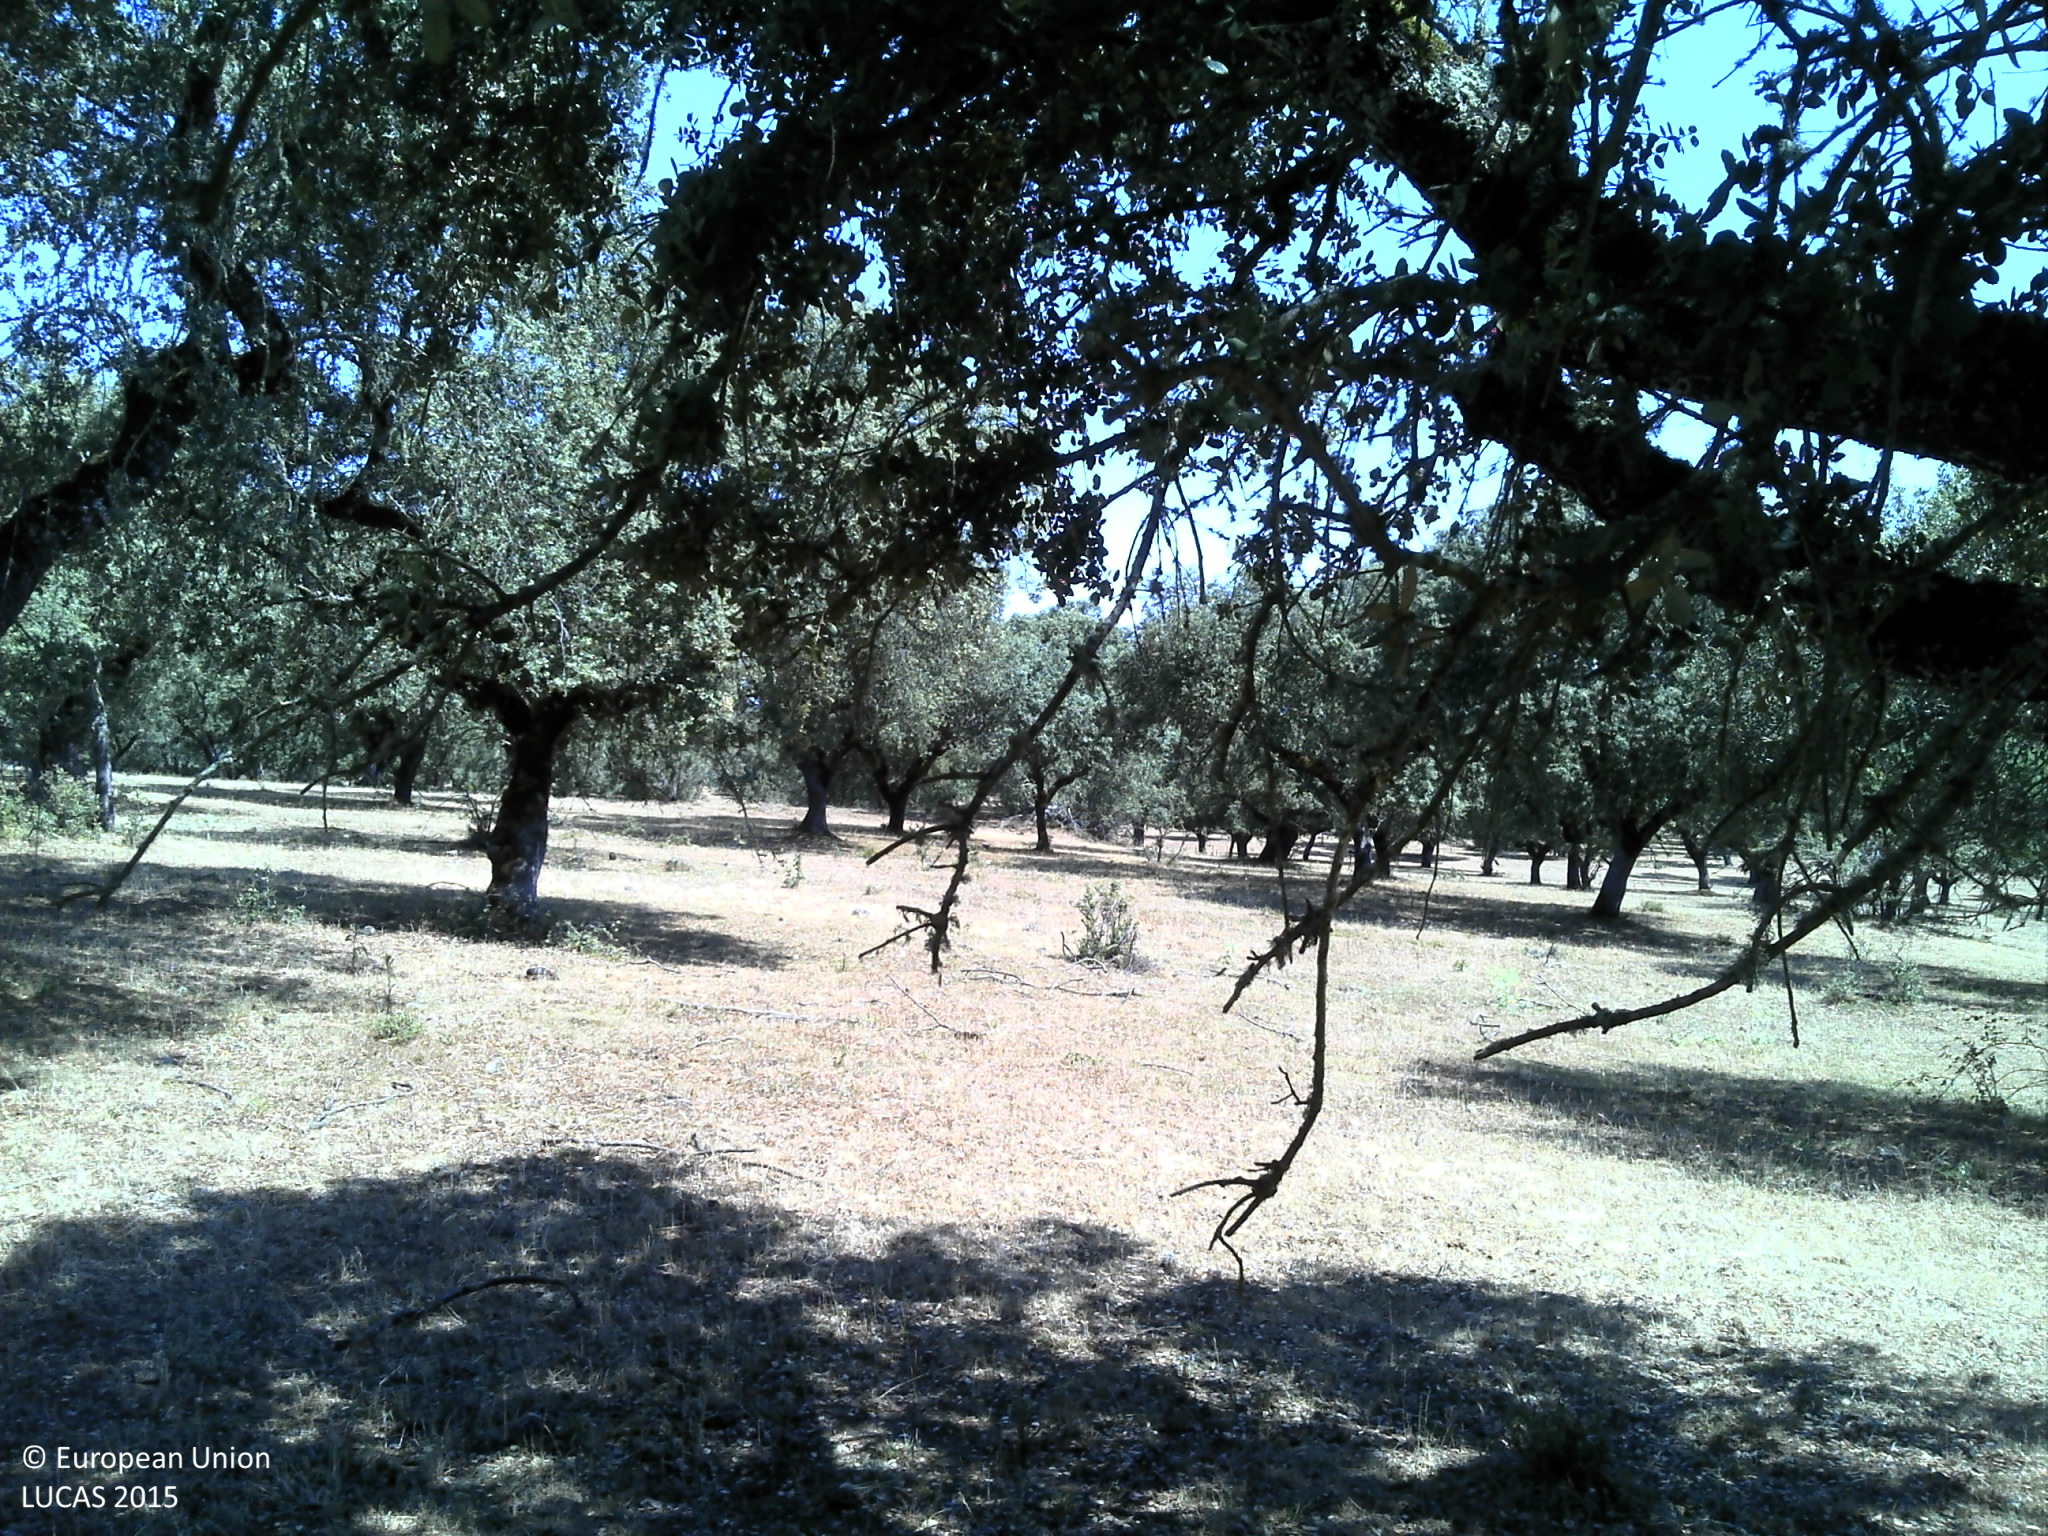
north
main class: Woodland
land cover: Broadleaved woodland
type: broadleaved evergreen forest
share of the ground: 50 - 75 %
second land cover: Grassland without tree/shrub cover
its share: 10 - 25 %
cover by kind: broadleaved forest trees 50 %, herbaceous plants 25 %, unconsolidated bare surface 25 %
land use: Forestry
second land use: Agriculture (excluding fallow land and kitchen gardens)
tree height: > 5 m
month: June
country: PT
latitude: 38.6428
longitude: -8.0949
